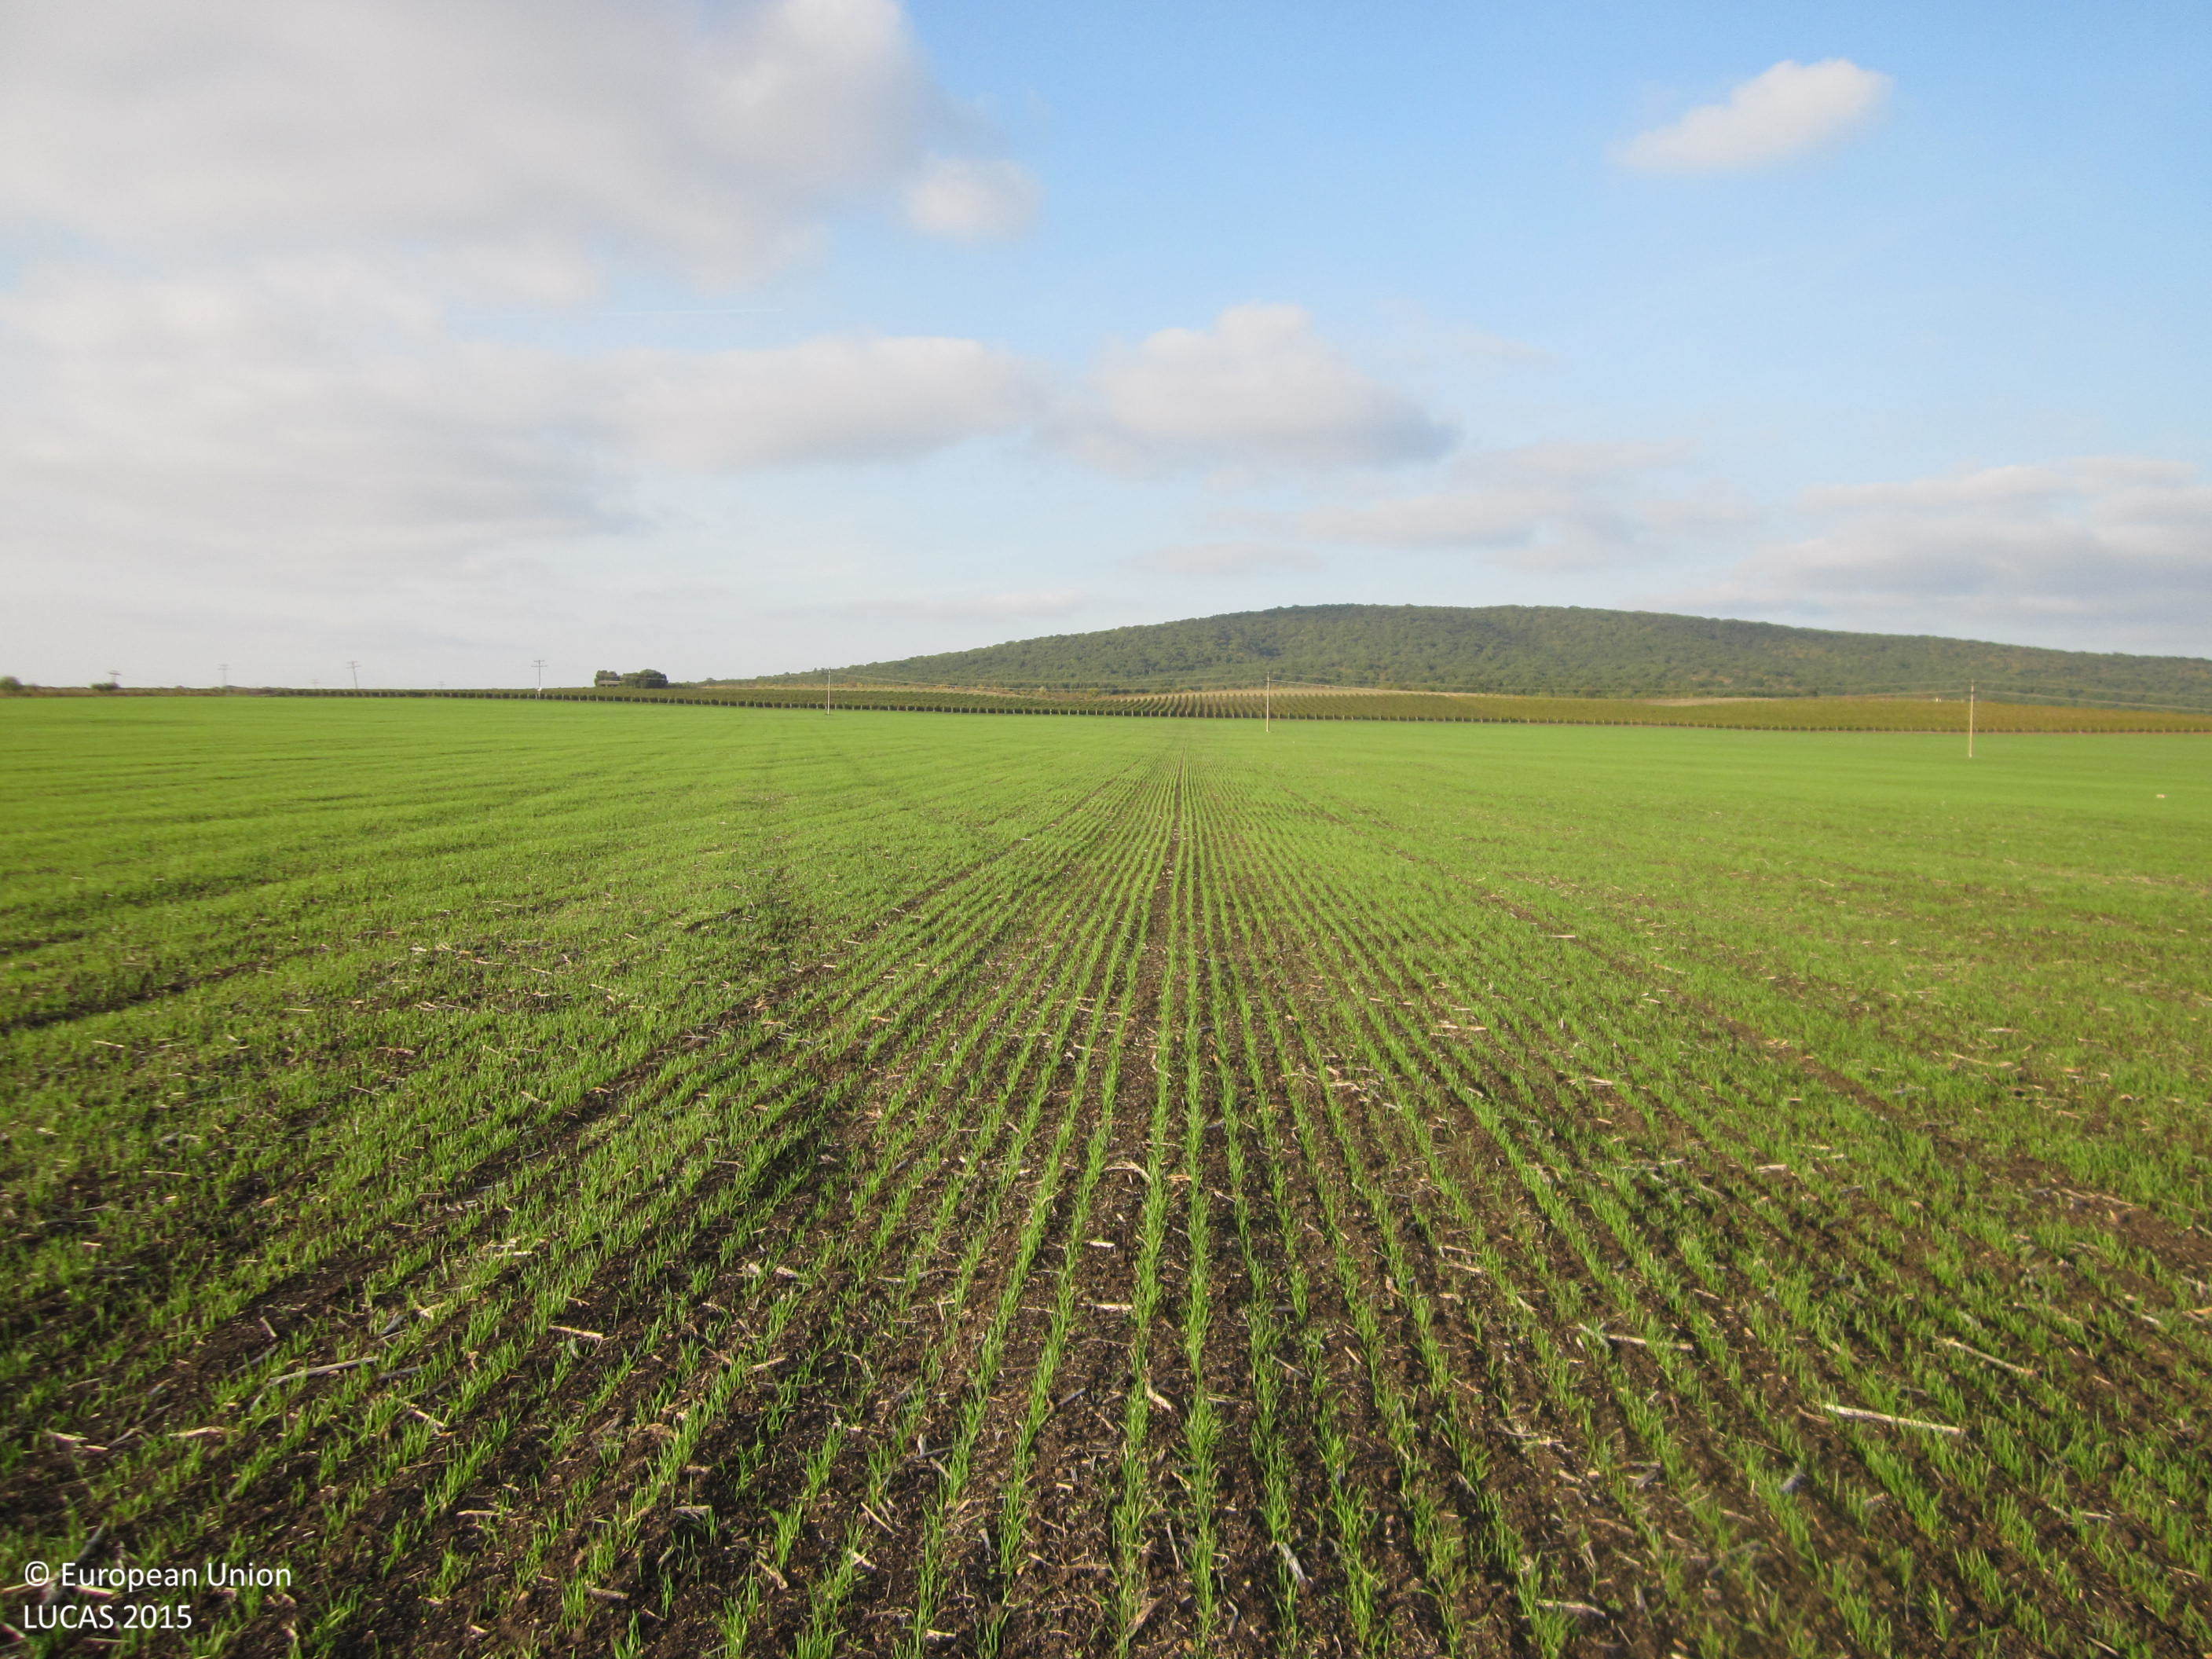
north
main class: Cropland
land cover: Common wheat
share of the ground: 25 - 50 %
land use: Agriculture (excluding fallow land and kitchen gardens)
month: October
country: BG
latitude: 42.7274
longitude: 26.9228
